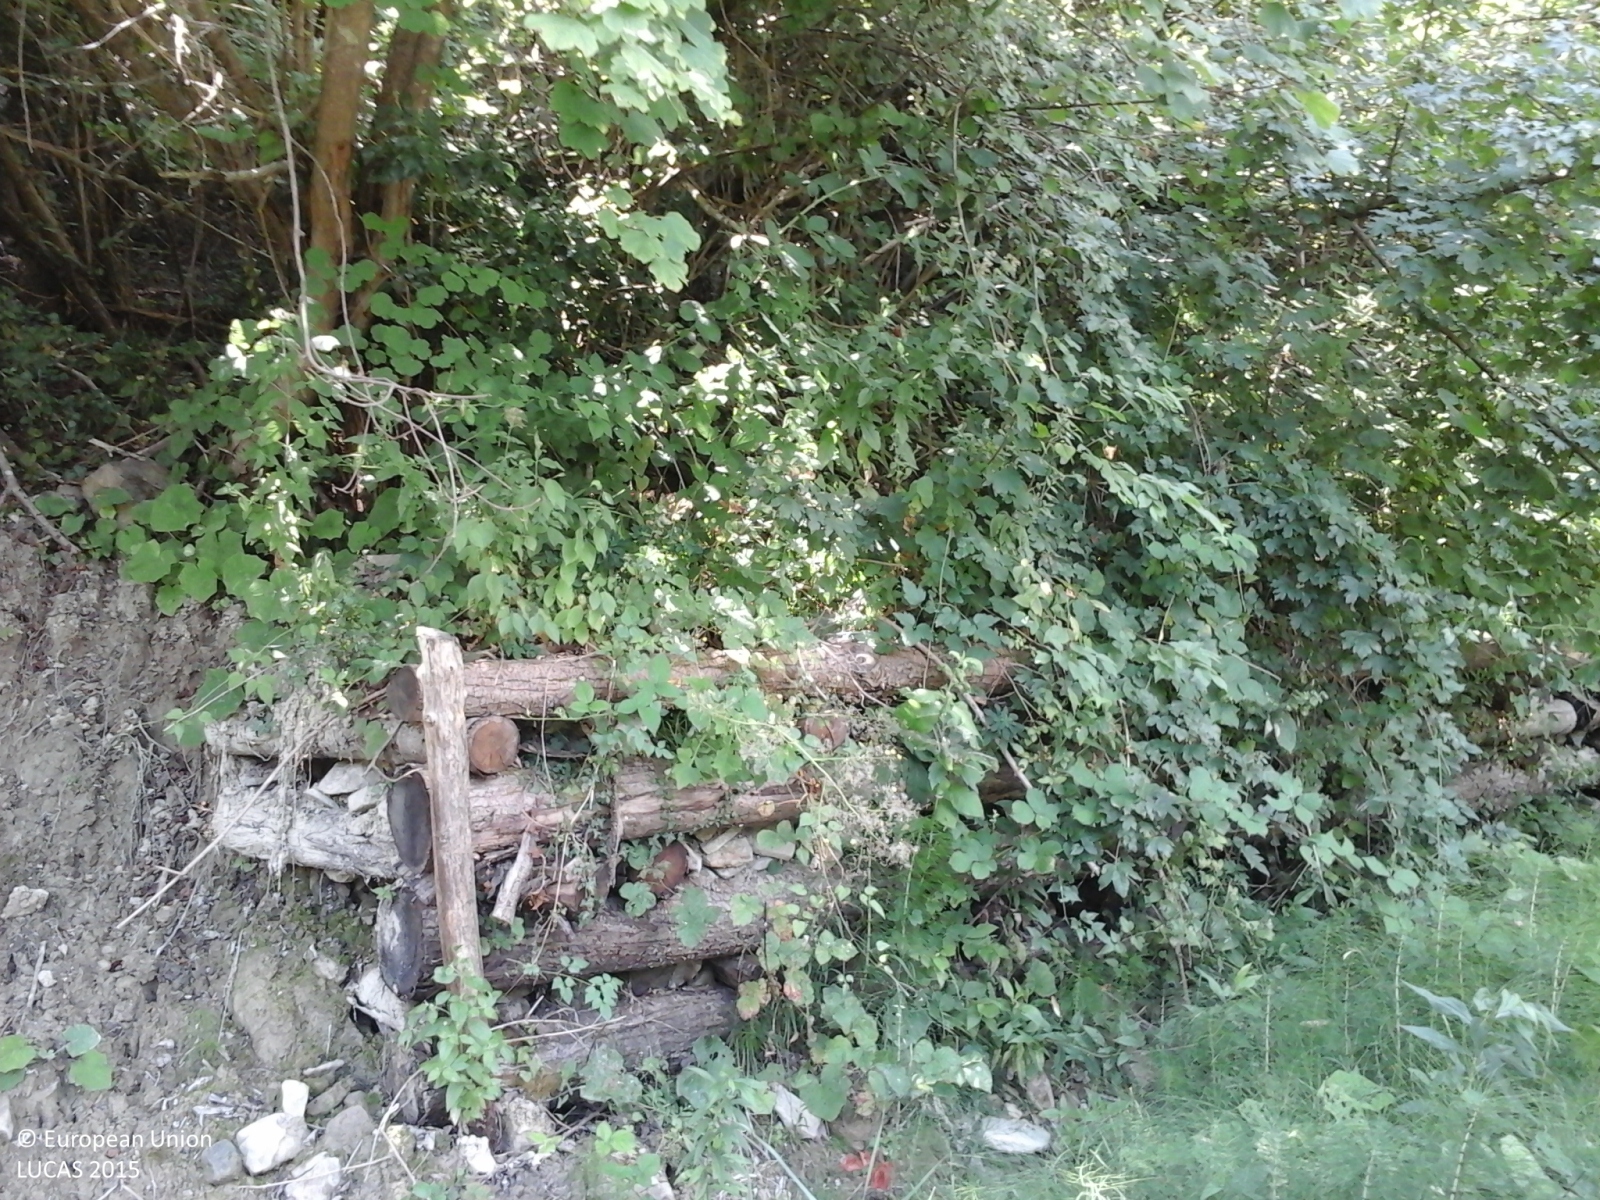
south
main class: Woodland
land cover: Broadleaved woodland
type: floodplain forest
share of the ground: > 75 %
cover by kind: broadleaved forest trees 100 %
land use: Forestry
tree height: > 5 m
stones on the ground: < 10 %
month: August
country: IT
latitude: 44.4961
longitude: 8.1301
